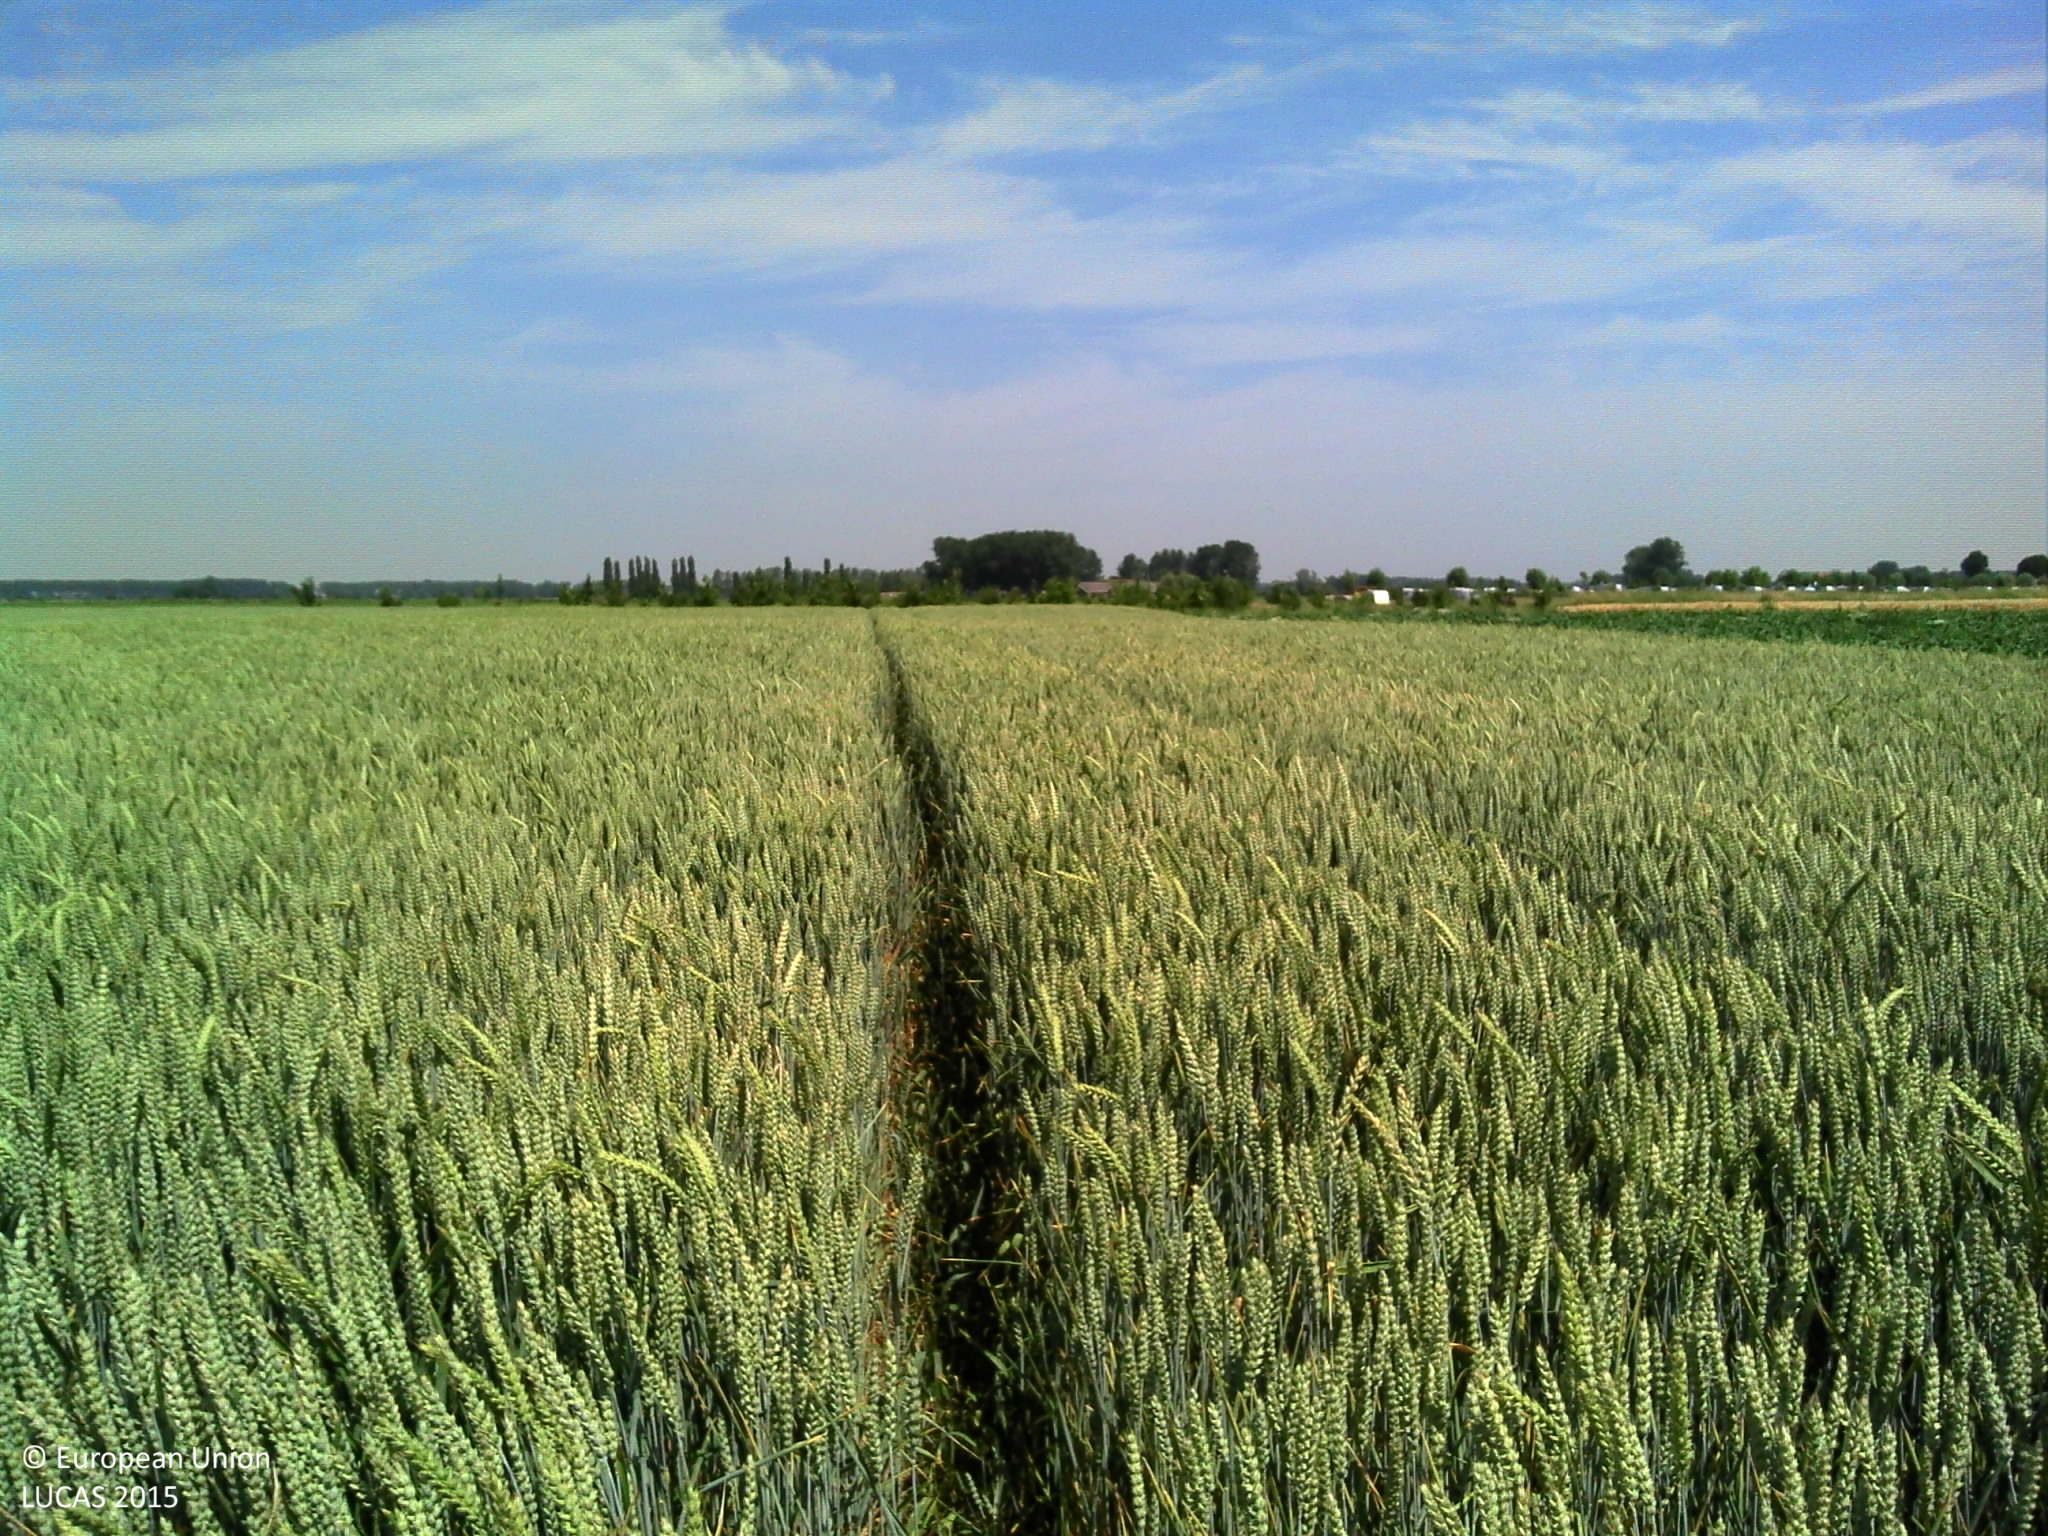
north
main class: Cropland
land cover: Common wheat
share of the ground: > 75 %
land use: Agriculture (excluding fallow land and kitchen gardens)
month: July
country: BE
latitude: 51.2729
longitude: 3.3836
